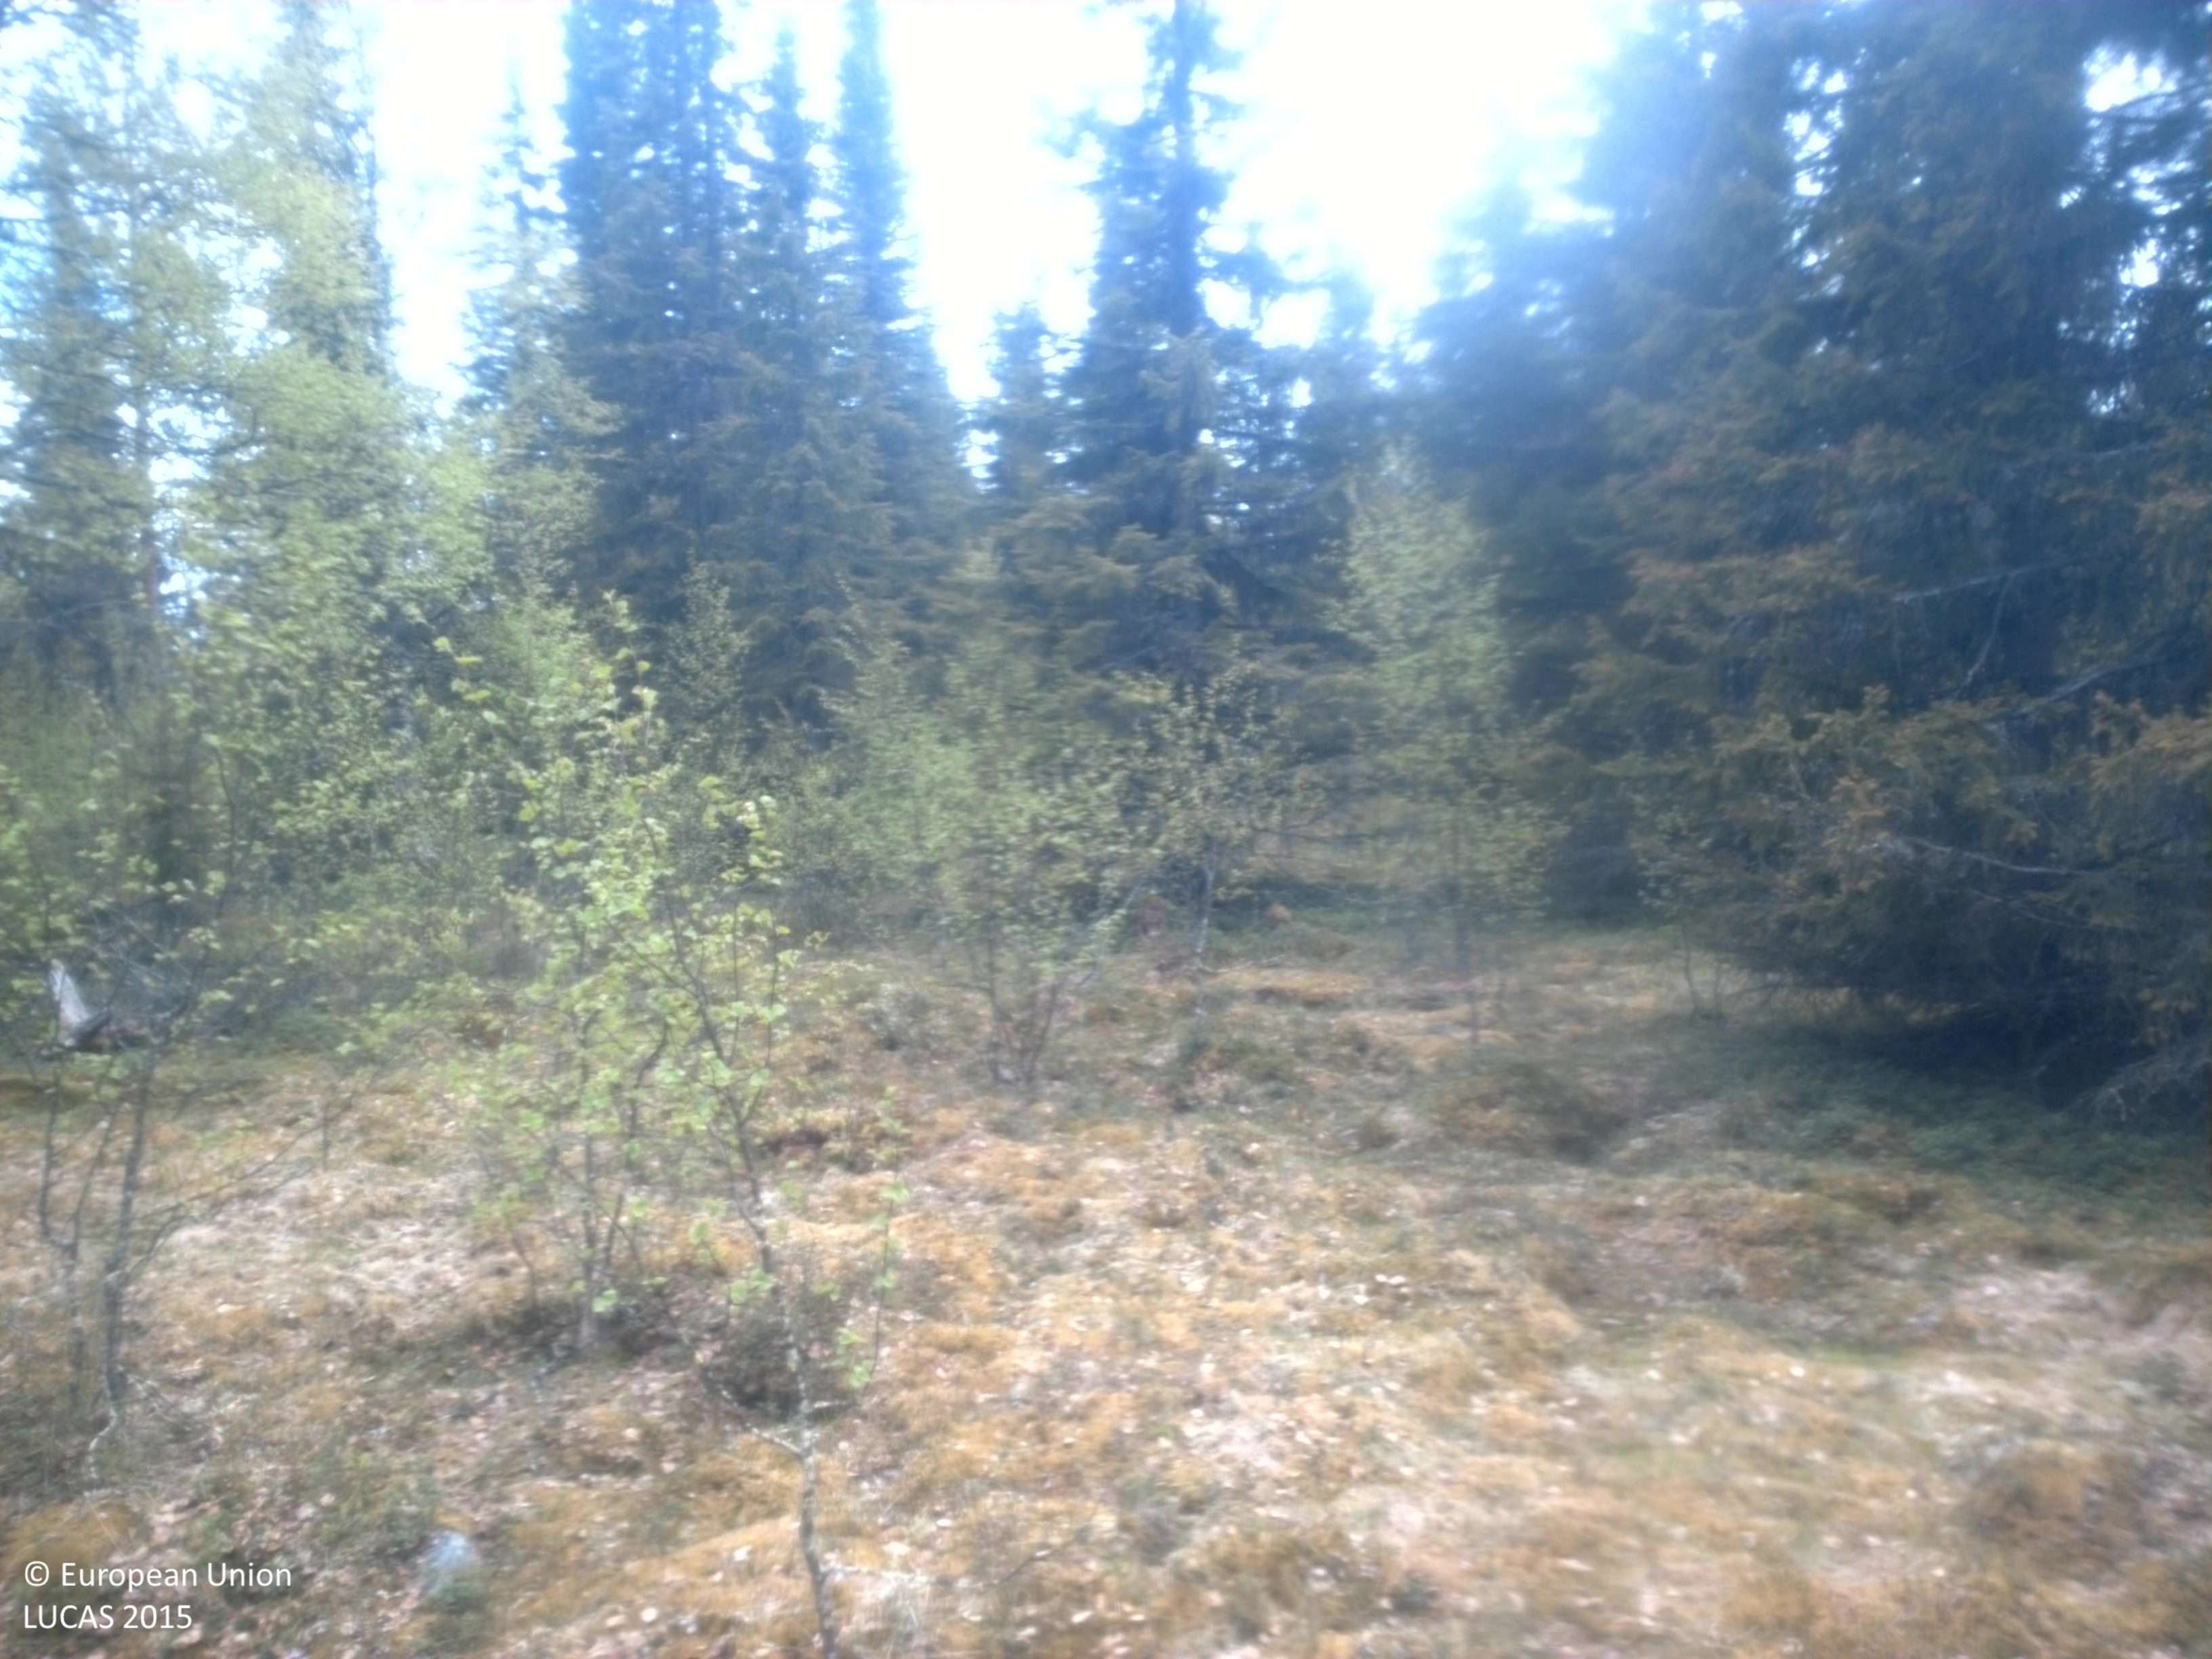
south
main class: Woodland
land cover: Broadleaved woodland
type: boreal forest
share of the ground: 25 - 50 %
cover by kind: broadleaved forest trees 35 %, herbaceous plants 35 %, lichens and mosses 15 %, unconsolidated bare surface 10 %, coniferous forest trees 5 %
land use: Forestry
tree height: < 5 m
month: June
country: SE
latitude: 64.3906
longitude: 17.7440
